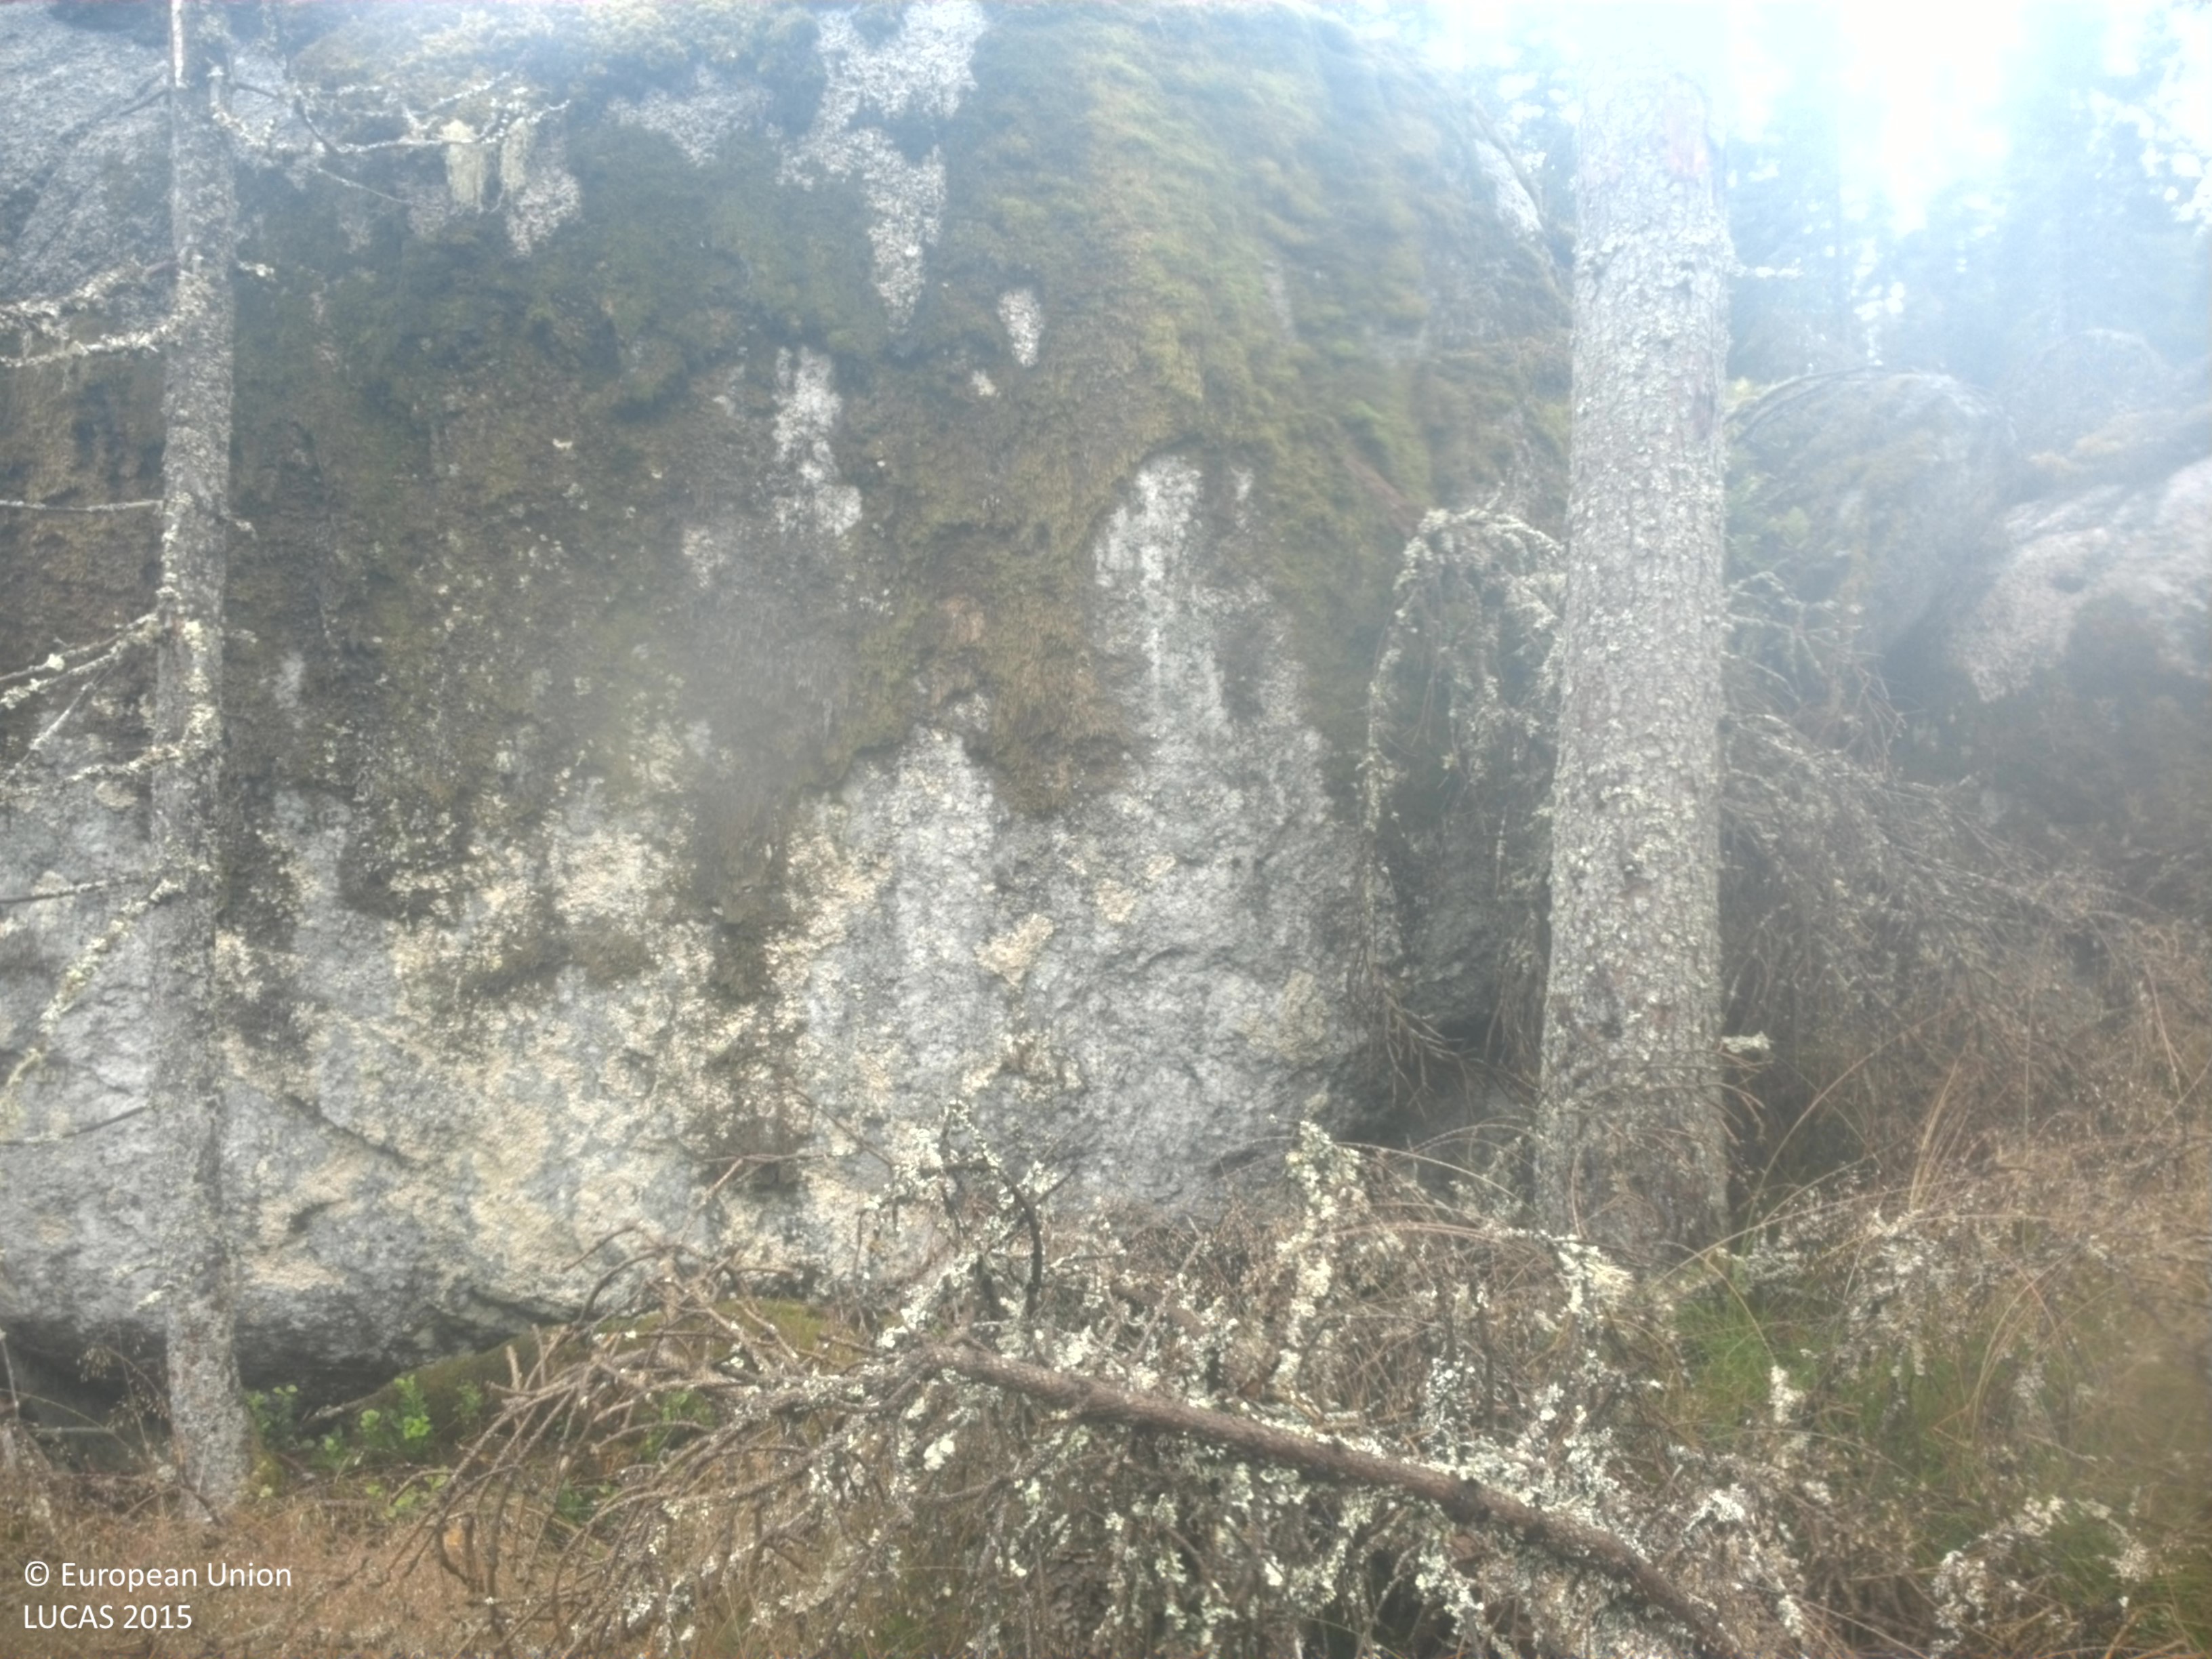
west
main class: Woodland
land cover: Broadleaved woodland
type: boreal forest
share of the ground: 10 - 25 %
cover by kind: herbaceous plants 50 %, shrubs 25 %, broadleaved forest trees 10 %, consolidated bare surface 10 %, lichens and mosses 5 %
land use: Forestry
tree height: > 5 m
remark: Clear cut
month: July
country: SE
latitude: 59.2366
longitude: 14.7066
